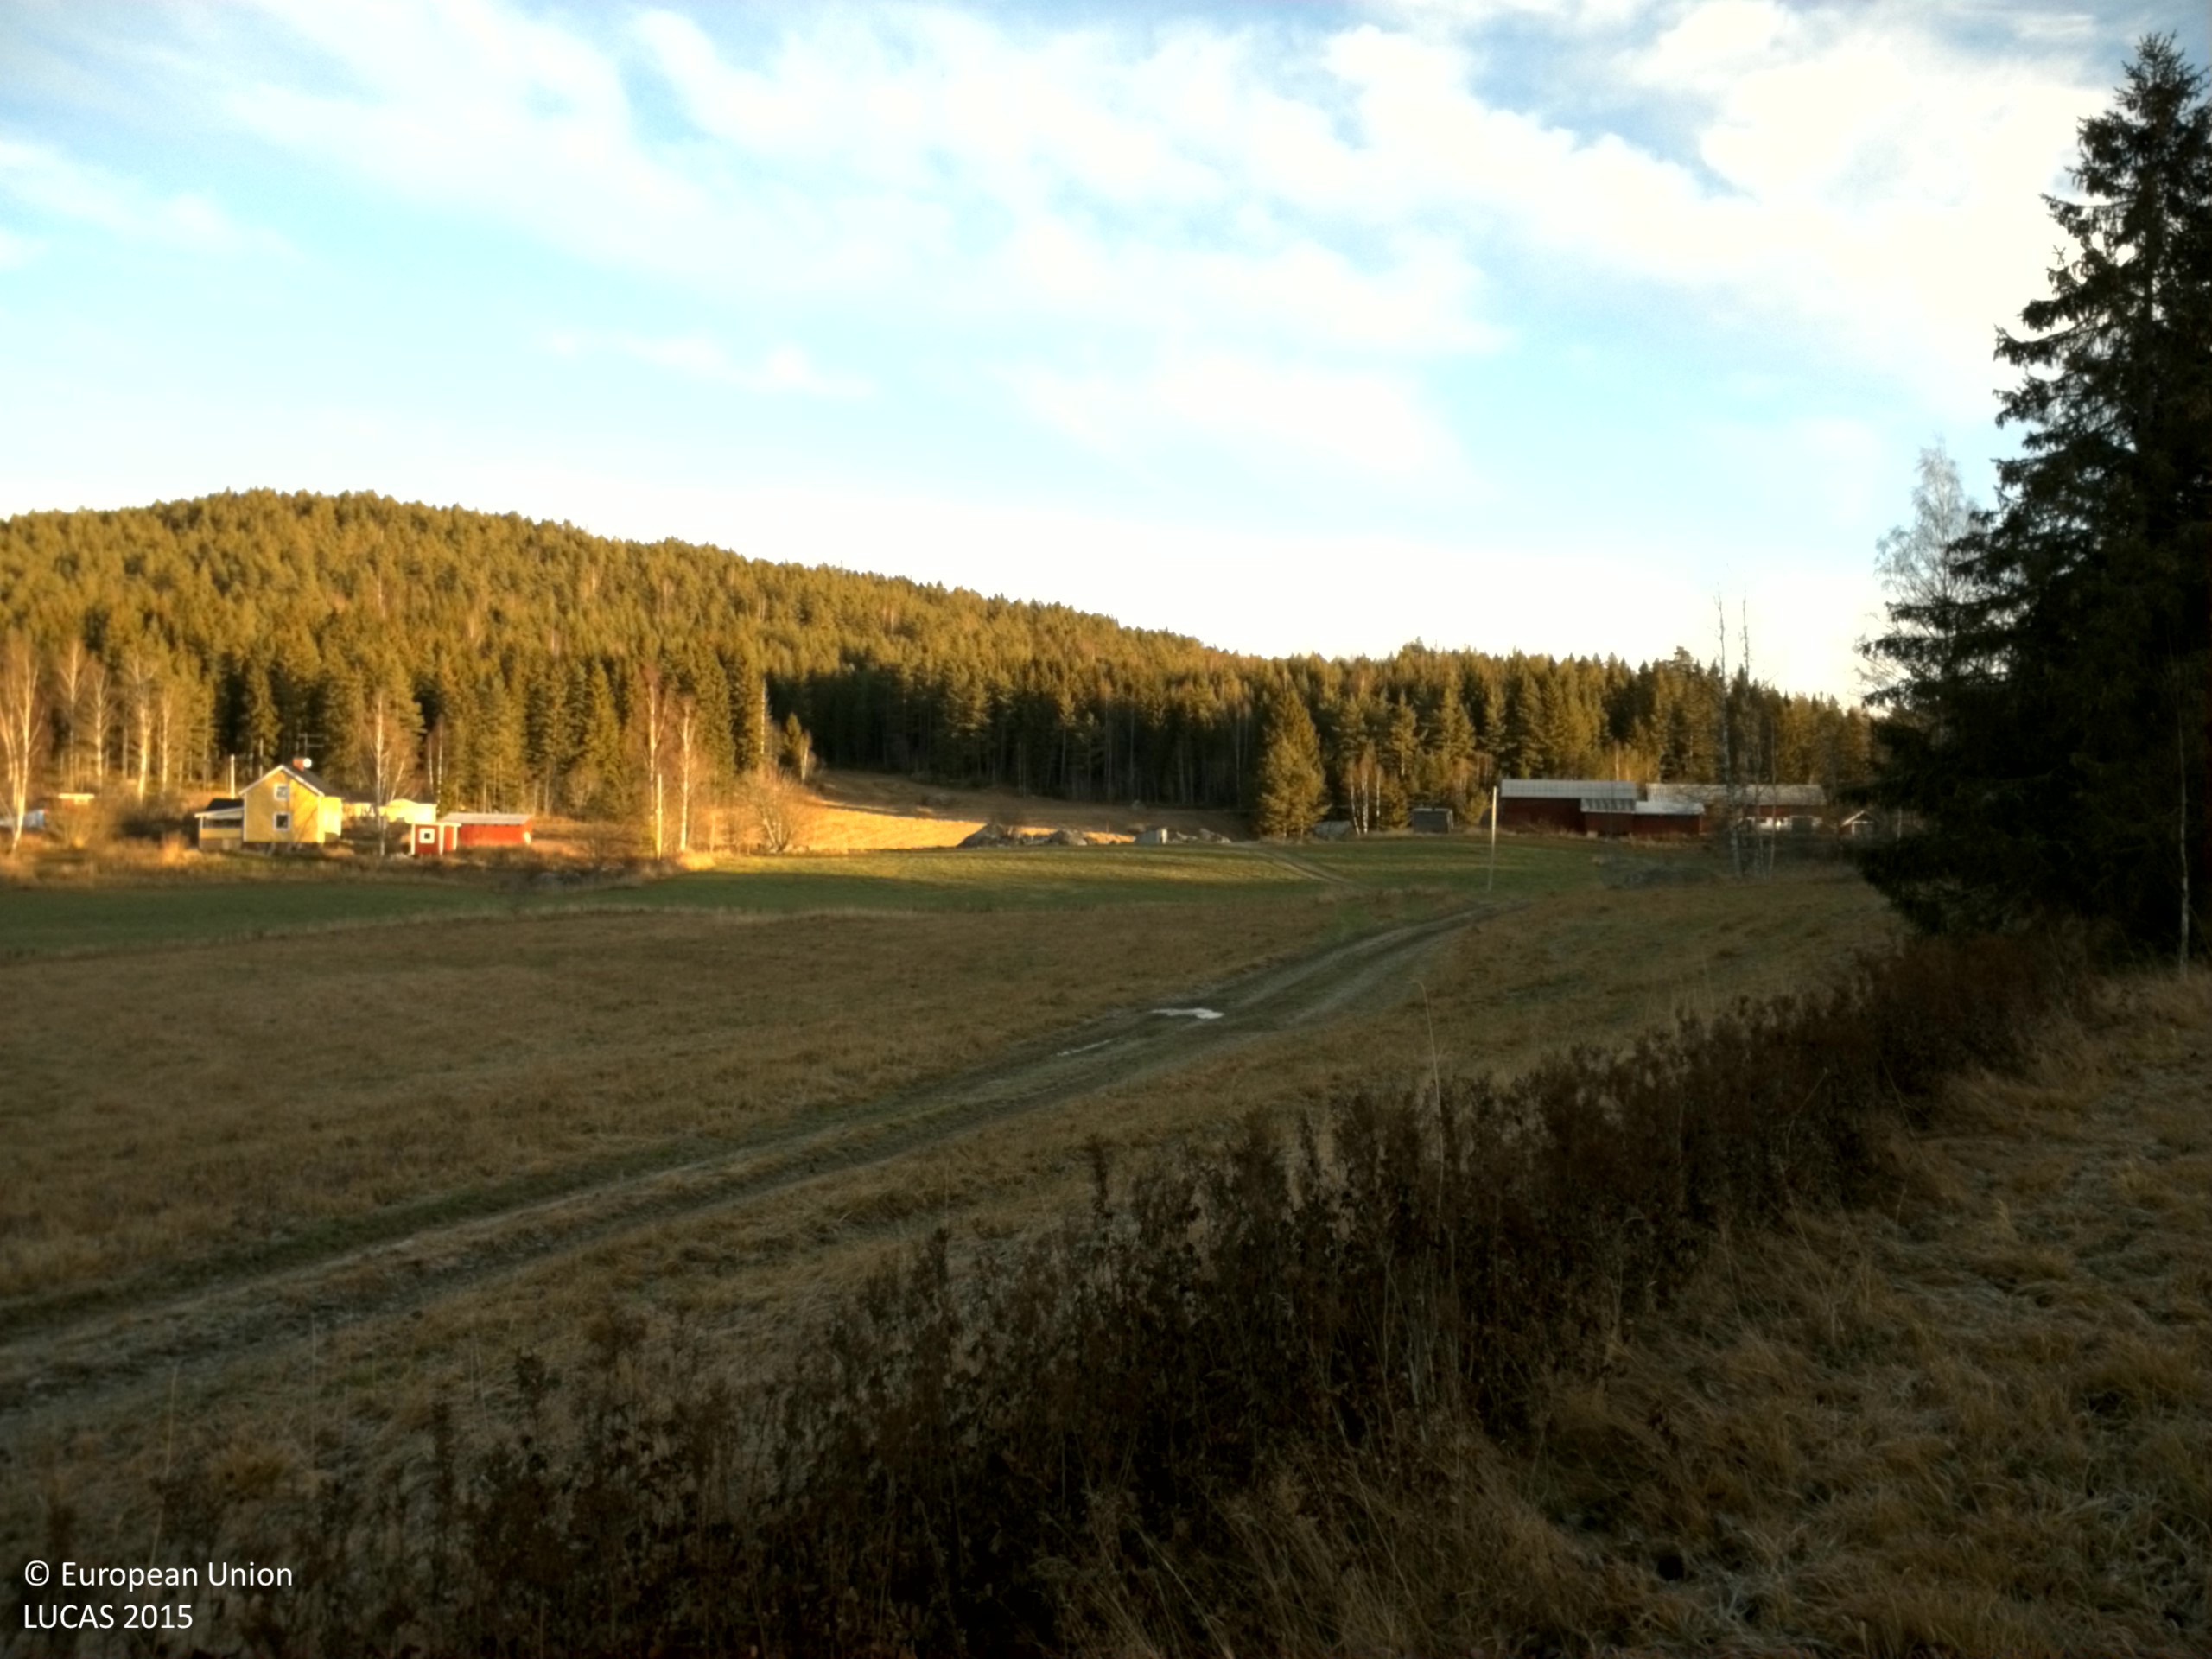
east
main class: Cropland
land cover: Temporary grasslands
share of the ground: > 75 %
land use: Agriculture (excluding fallow land and kitchen gardens)
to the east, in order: Temporary grasslands; Shruby margins; Managed hedges; Shruby margins; Grassland without tree/shrub cover; Tracks; Grassland without tree/shrub cover; Other leguminous and mixtures for fodder; Electric lines; Other leguminous and mixtures for fodder; Tracks; Grassland without tree/shrub cover; Ditches and canals; Paved roads, cycling and walking lanes; Ditches and canals; Grass margins; Other bare soil; Grass margins; Mixed cereals for fodder
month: November
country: SE
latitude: 61.2699
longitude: 16.6805
